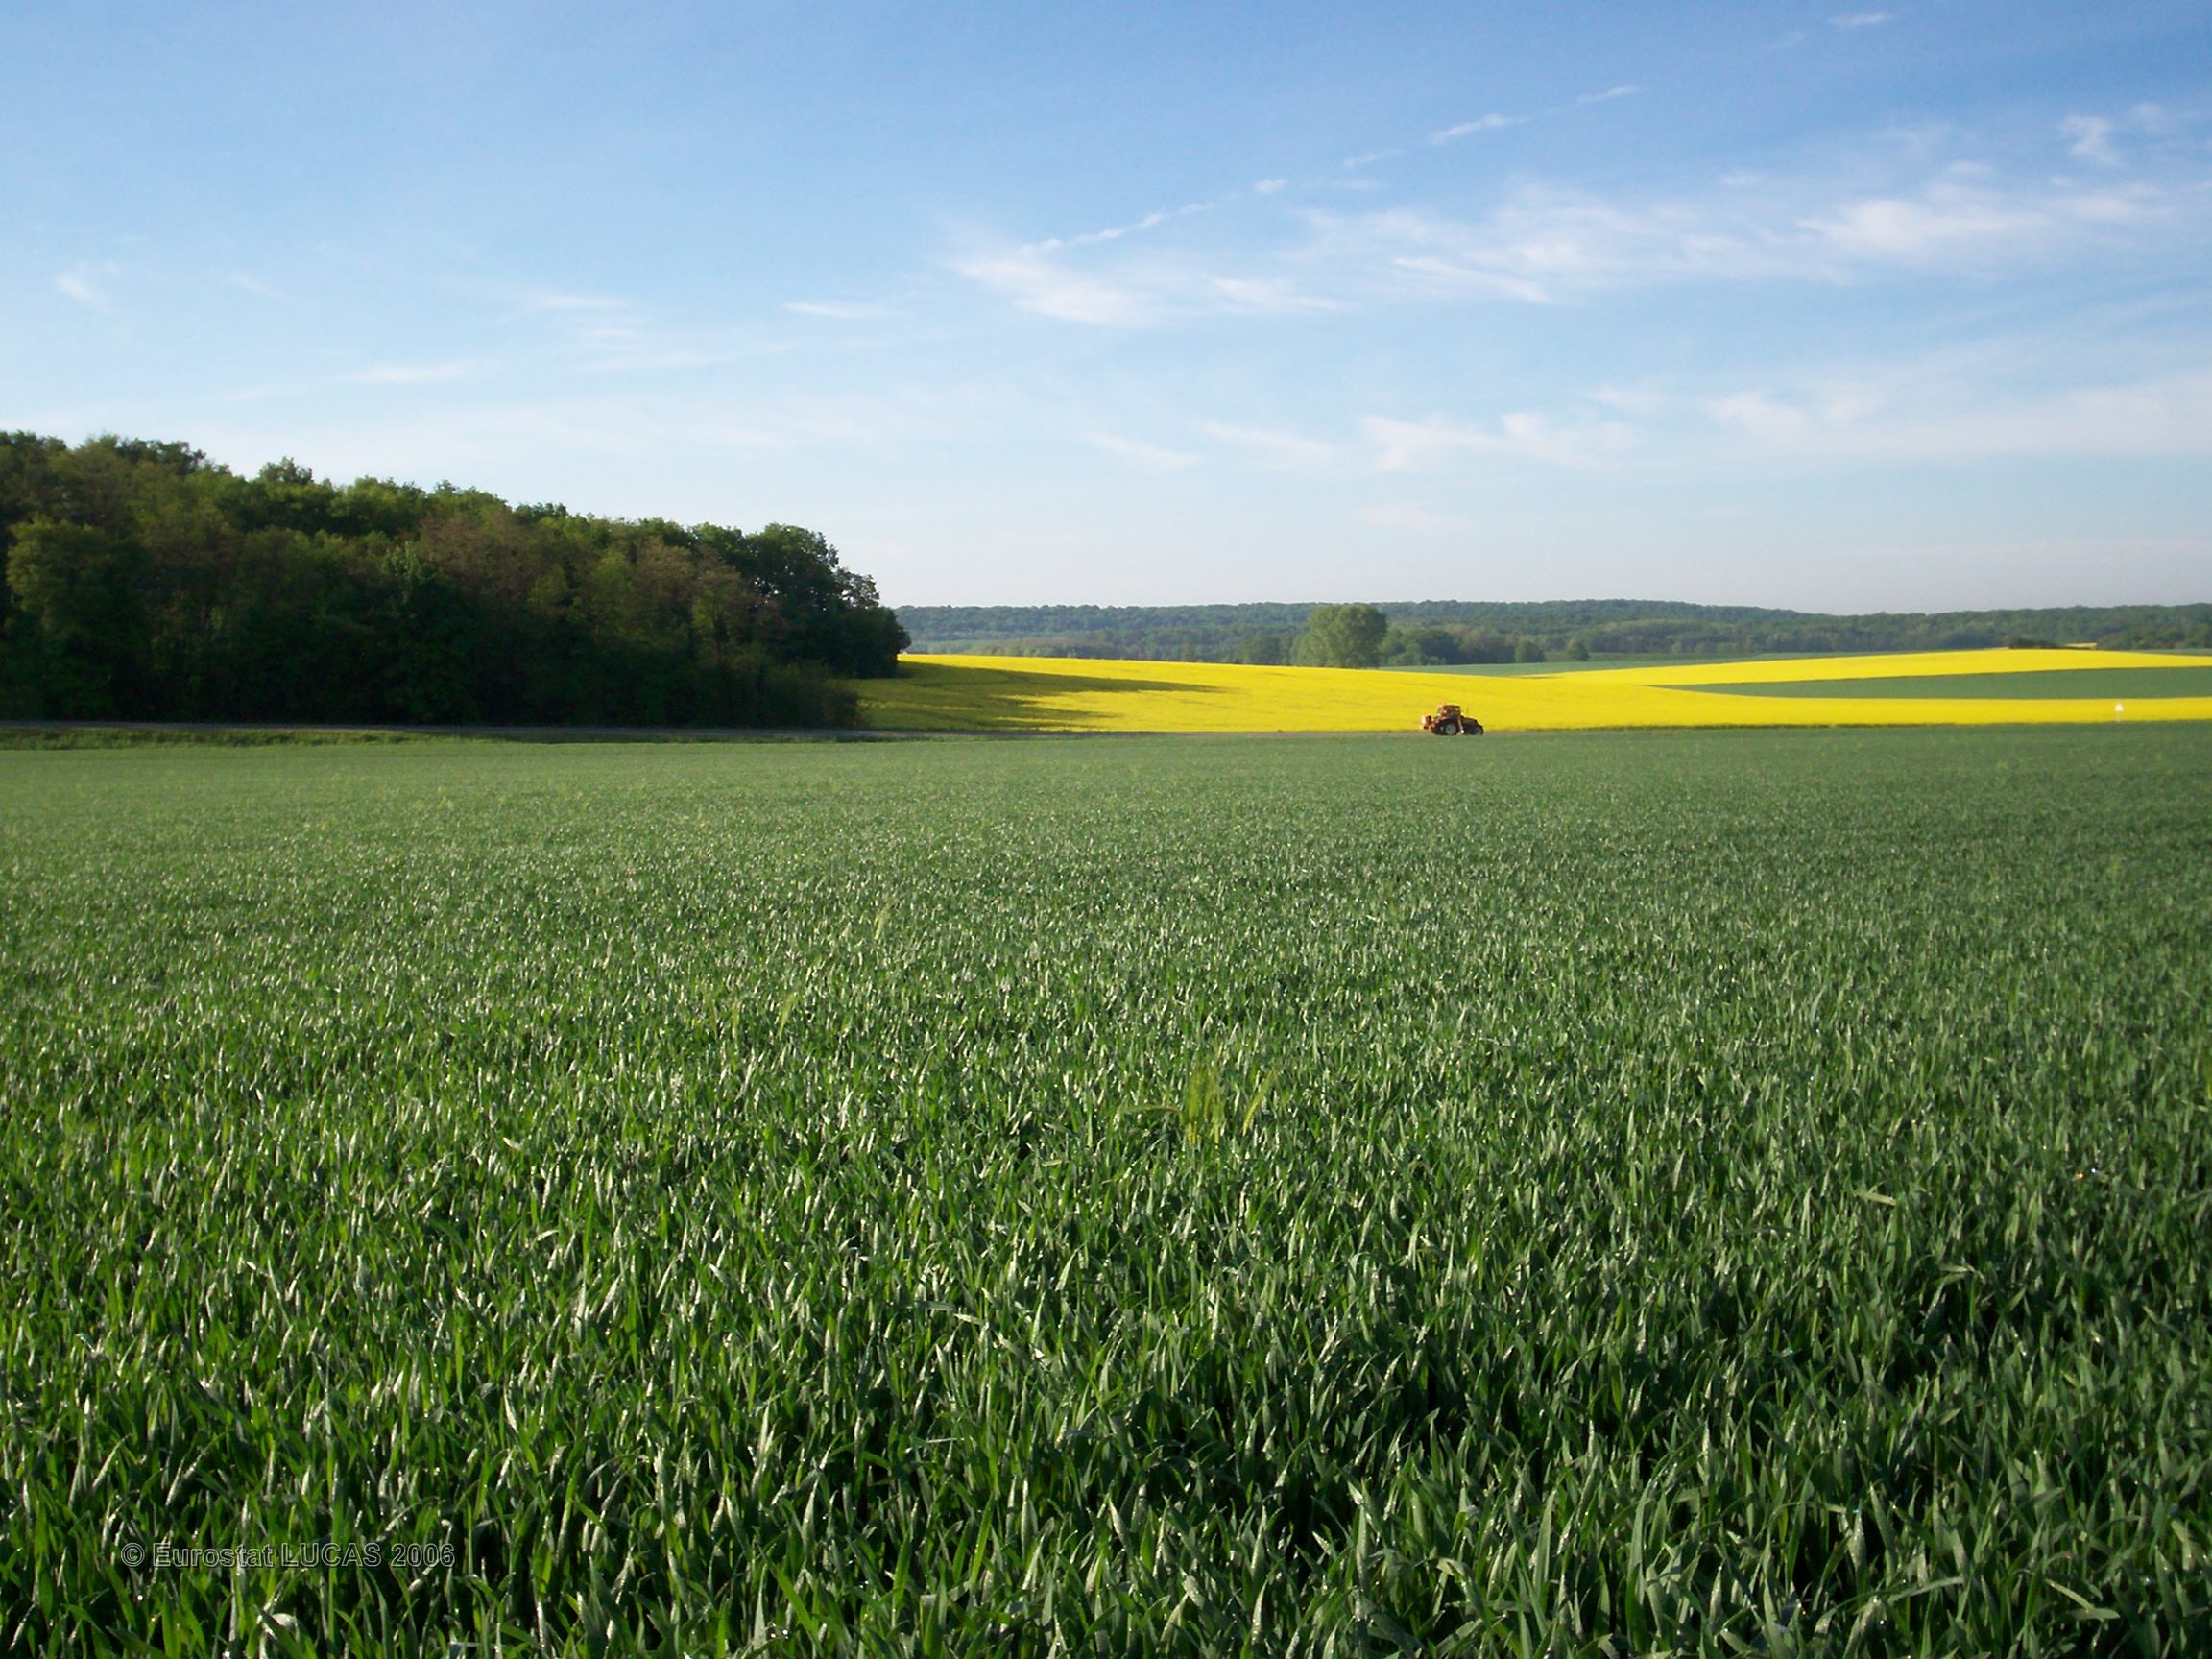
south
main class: Cropland
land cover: Barley
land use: Agriculture (excluding fallow land and kitchen gardens)
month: May
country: FR
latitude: 47.5110
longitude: 5.3134
